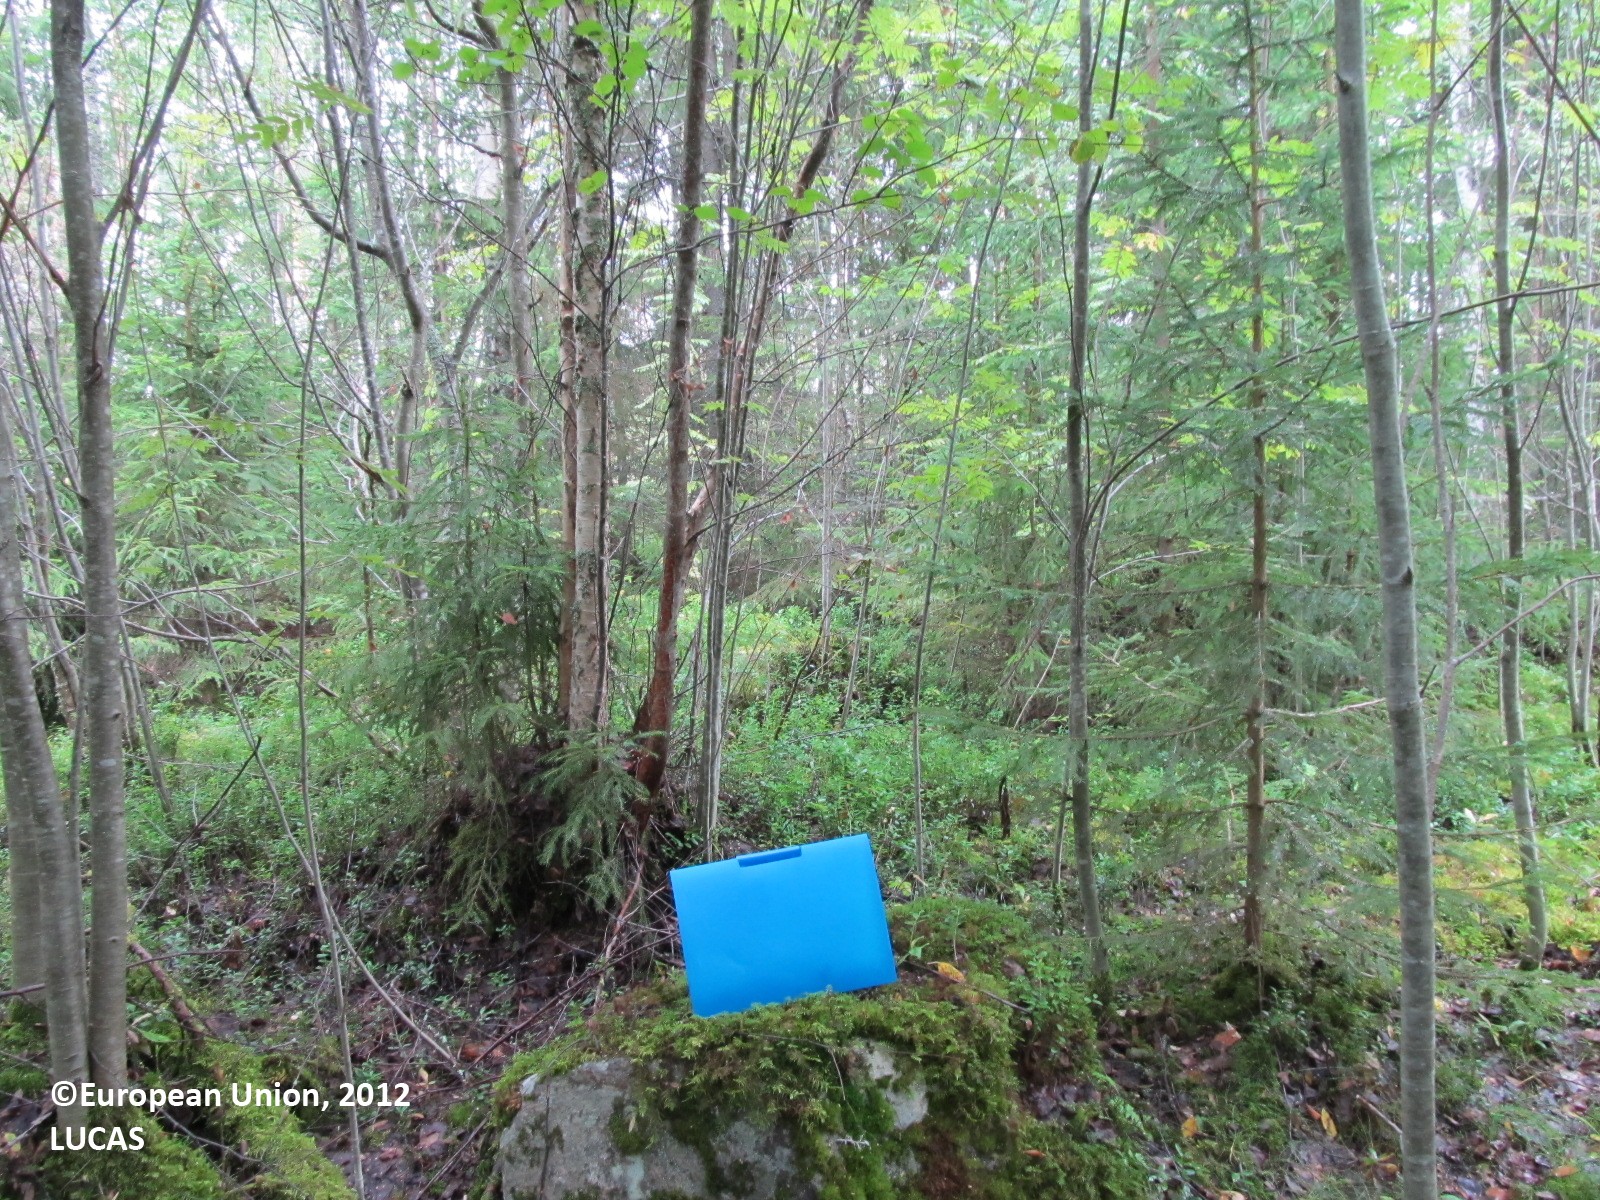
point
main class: Woodland
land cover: Broadleaved woodland
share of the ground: > 75 %
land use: Forestry
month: August
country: FI
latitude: 62.1306
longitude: 27.9625
